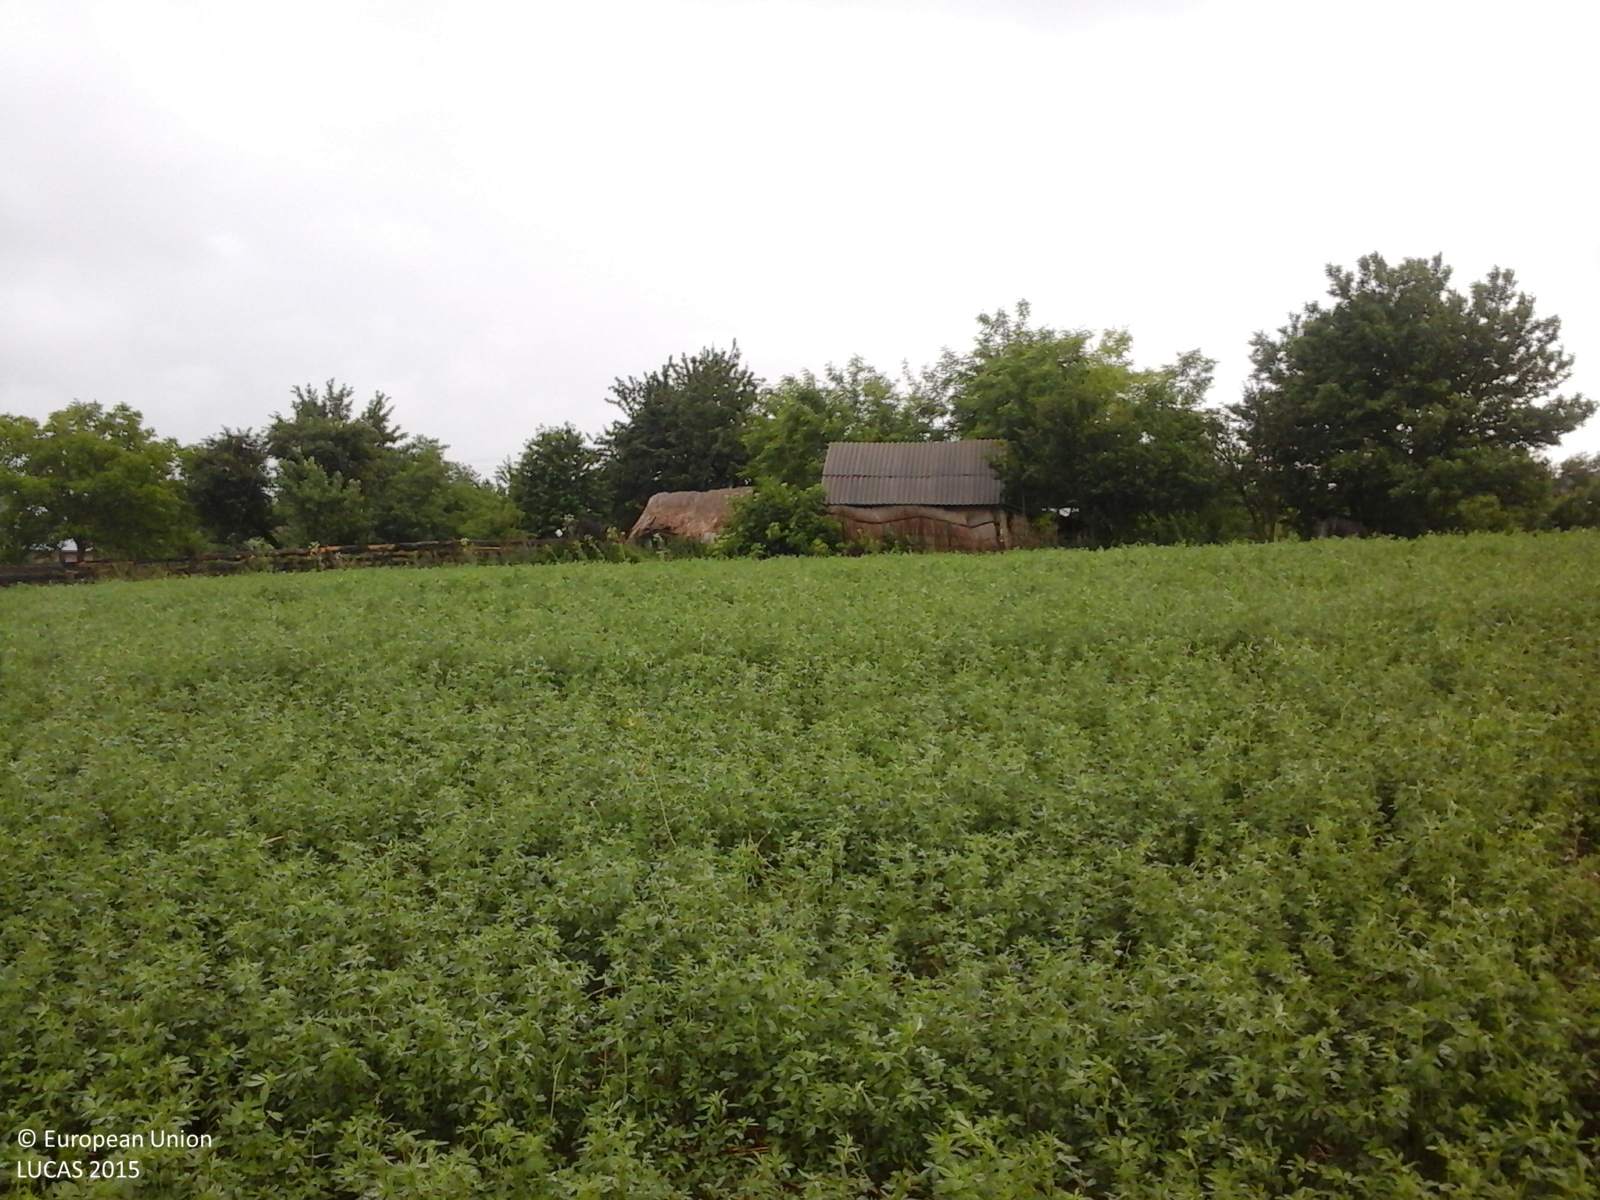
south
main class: Cropland
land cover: Lucerne
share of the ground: > 75 %
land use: Agriculture (excluding fallow land and kitchen gardens)
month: June
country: RO
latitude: 48.0252
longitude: 26.4361
